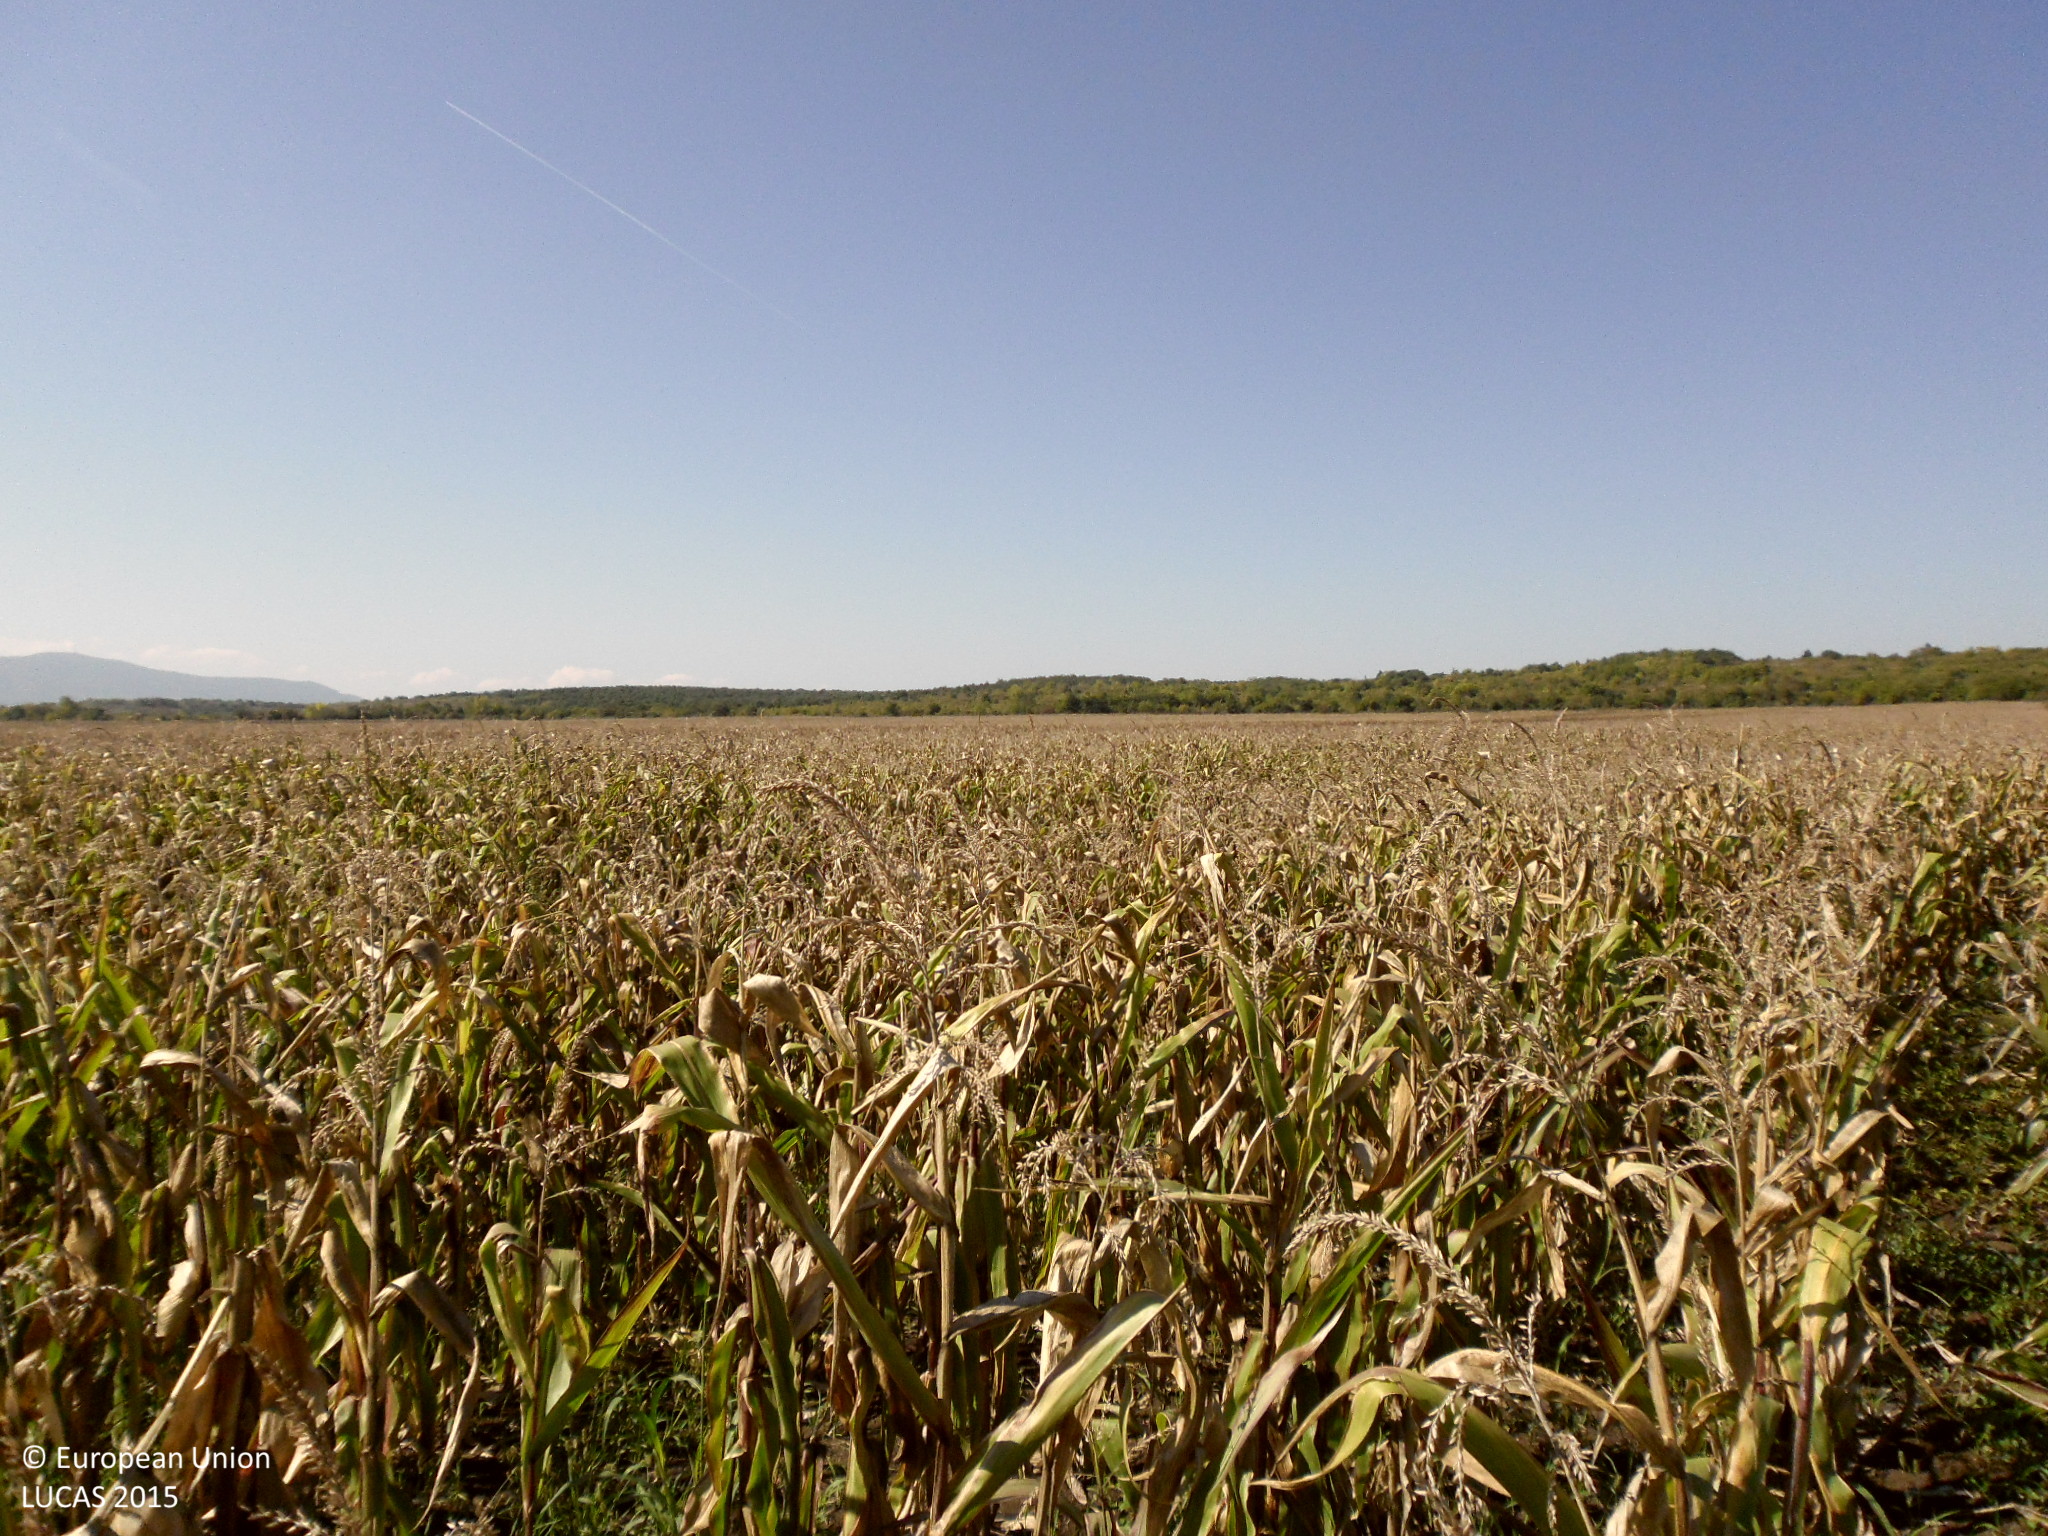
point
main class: Cropland
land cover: Maize
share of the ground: > 75 %
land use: Agriculture (excluding fallow land and kitchen gardens)
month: October
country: BG
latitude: 43.6549
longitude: 22.8699
